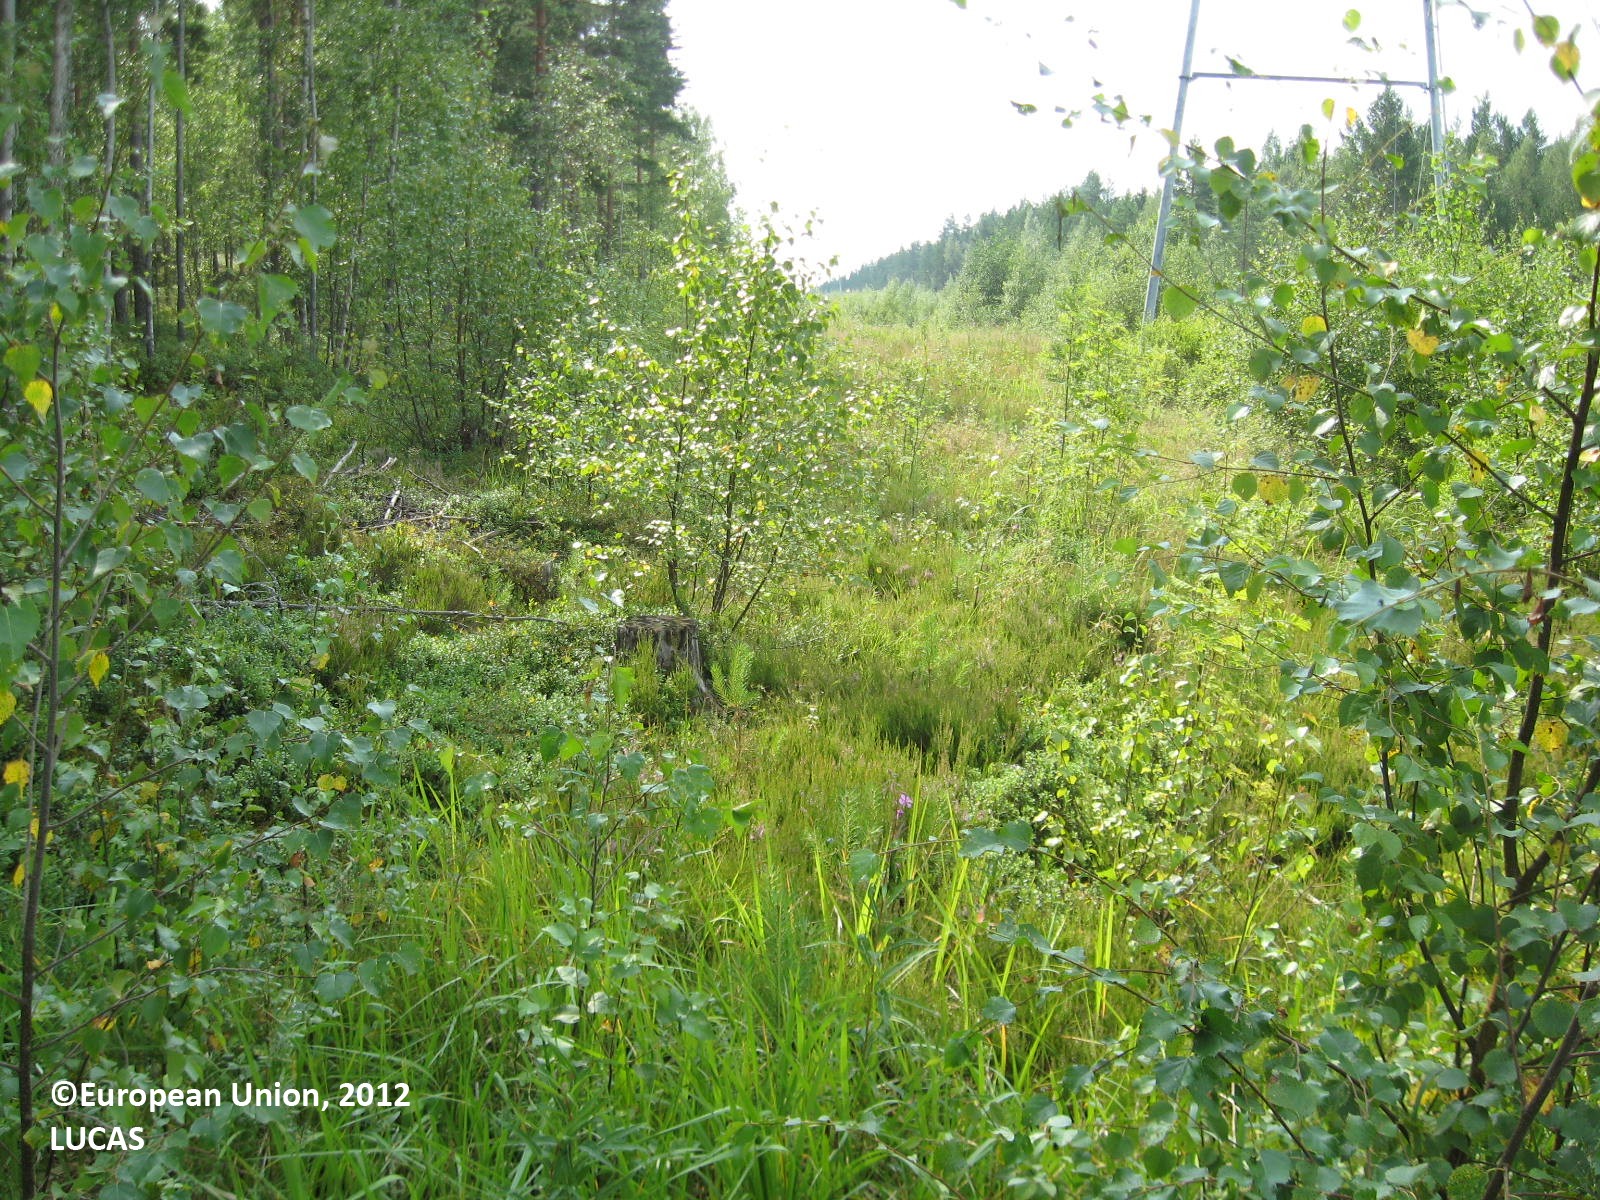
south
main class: Woodland
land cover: Other mixed woodland
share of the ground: 50 - 75 %
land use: Energy production
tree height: < 5 m
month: July
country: FI
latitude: 61.9518
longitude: 22.3927
